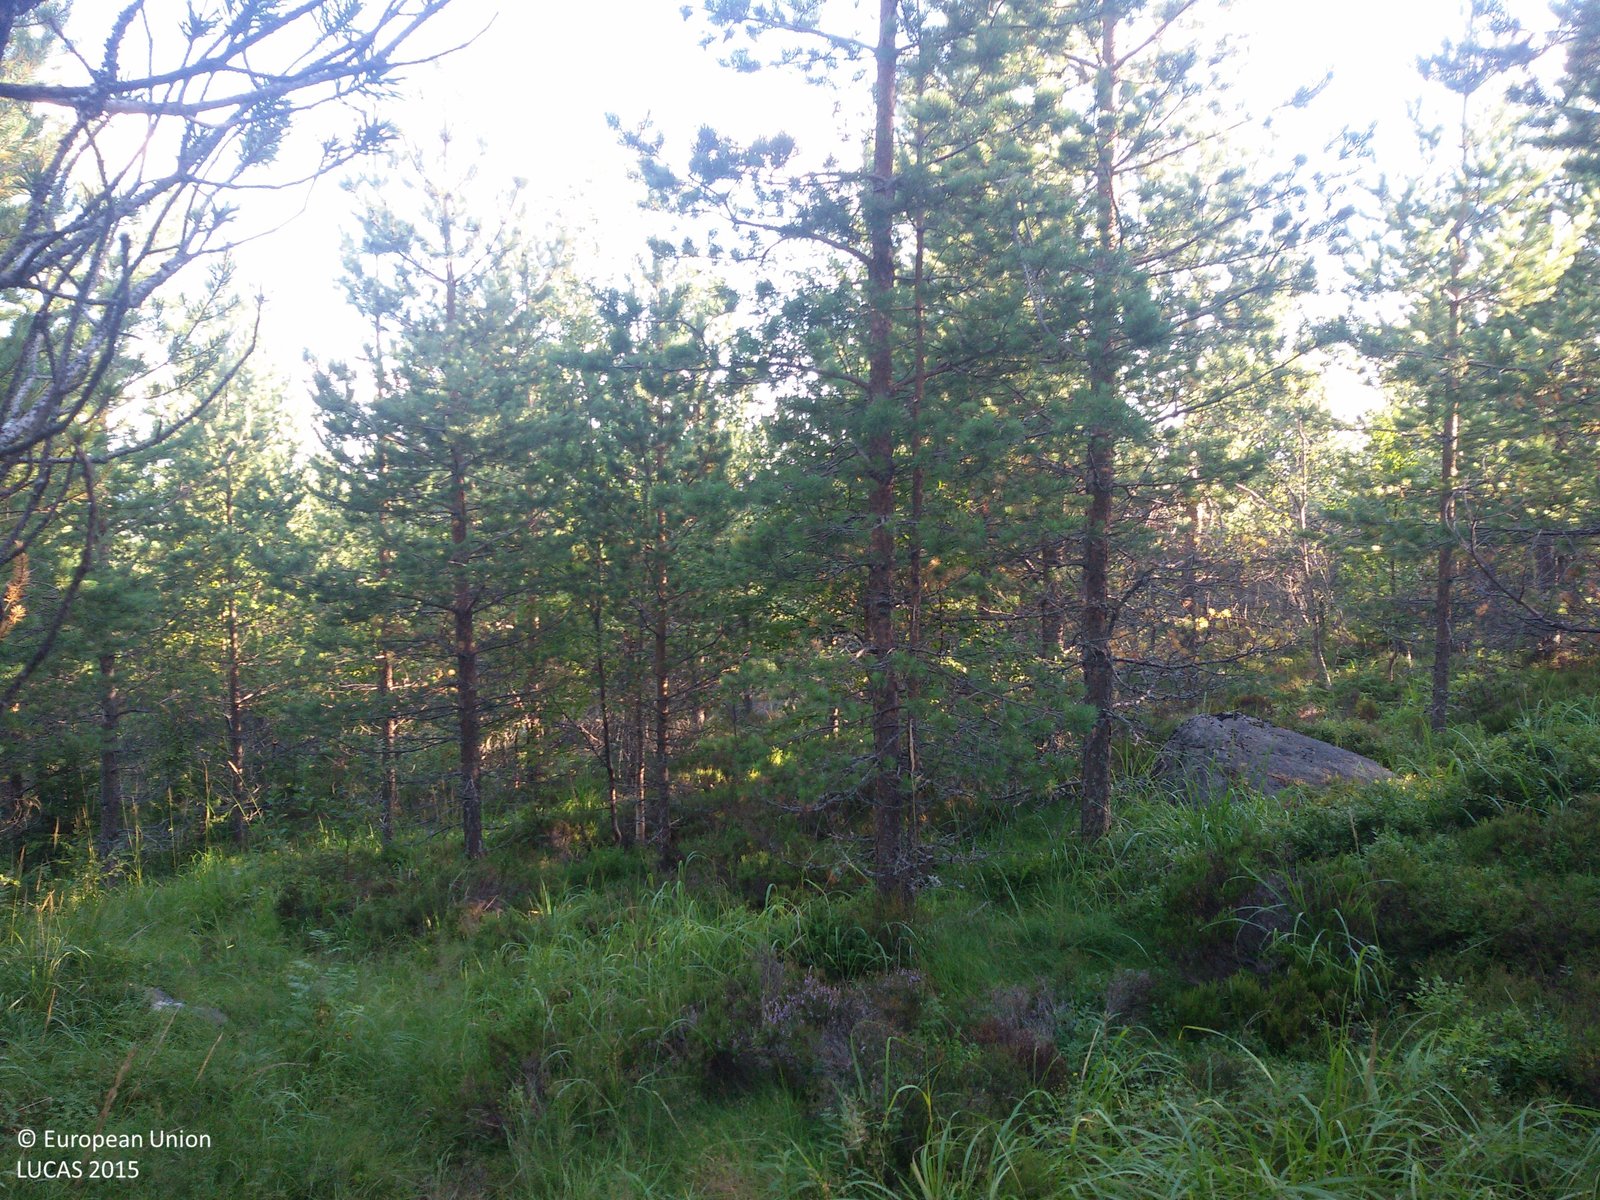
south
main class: Woodland
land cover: Pine dominated coniferous woodland
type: boreal forest
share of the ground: > 75 %
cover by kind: coniferous forest trees 90 %, herbaceous plants 5 %, lichens and mosses 5 %
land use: Forestry
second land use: Amenities, museums, leisure
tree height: > 5 m
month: August
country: SE
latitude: 60.9075
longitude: 15.8678
